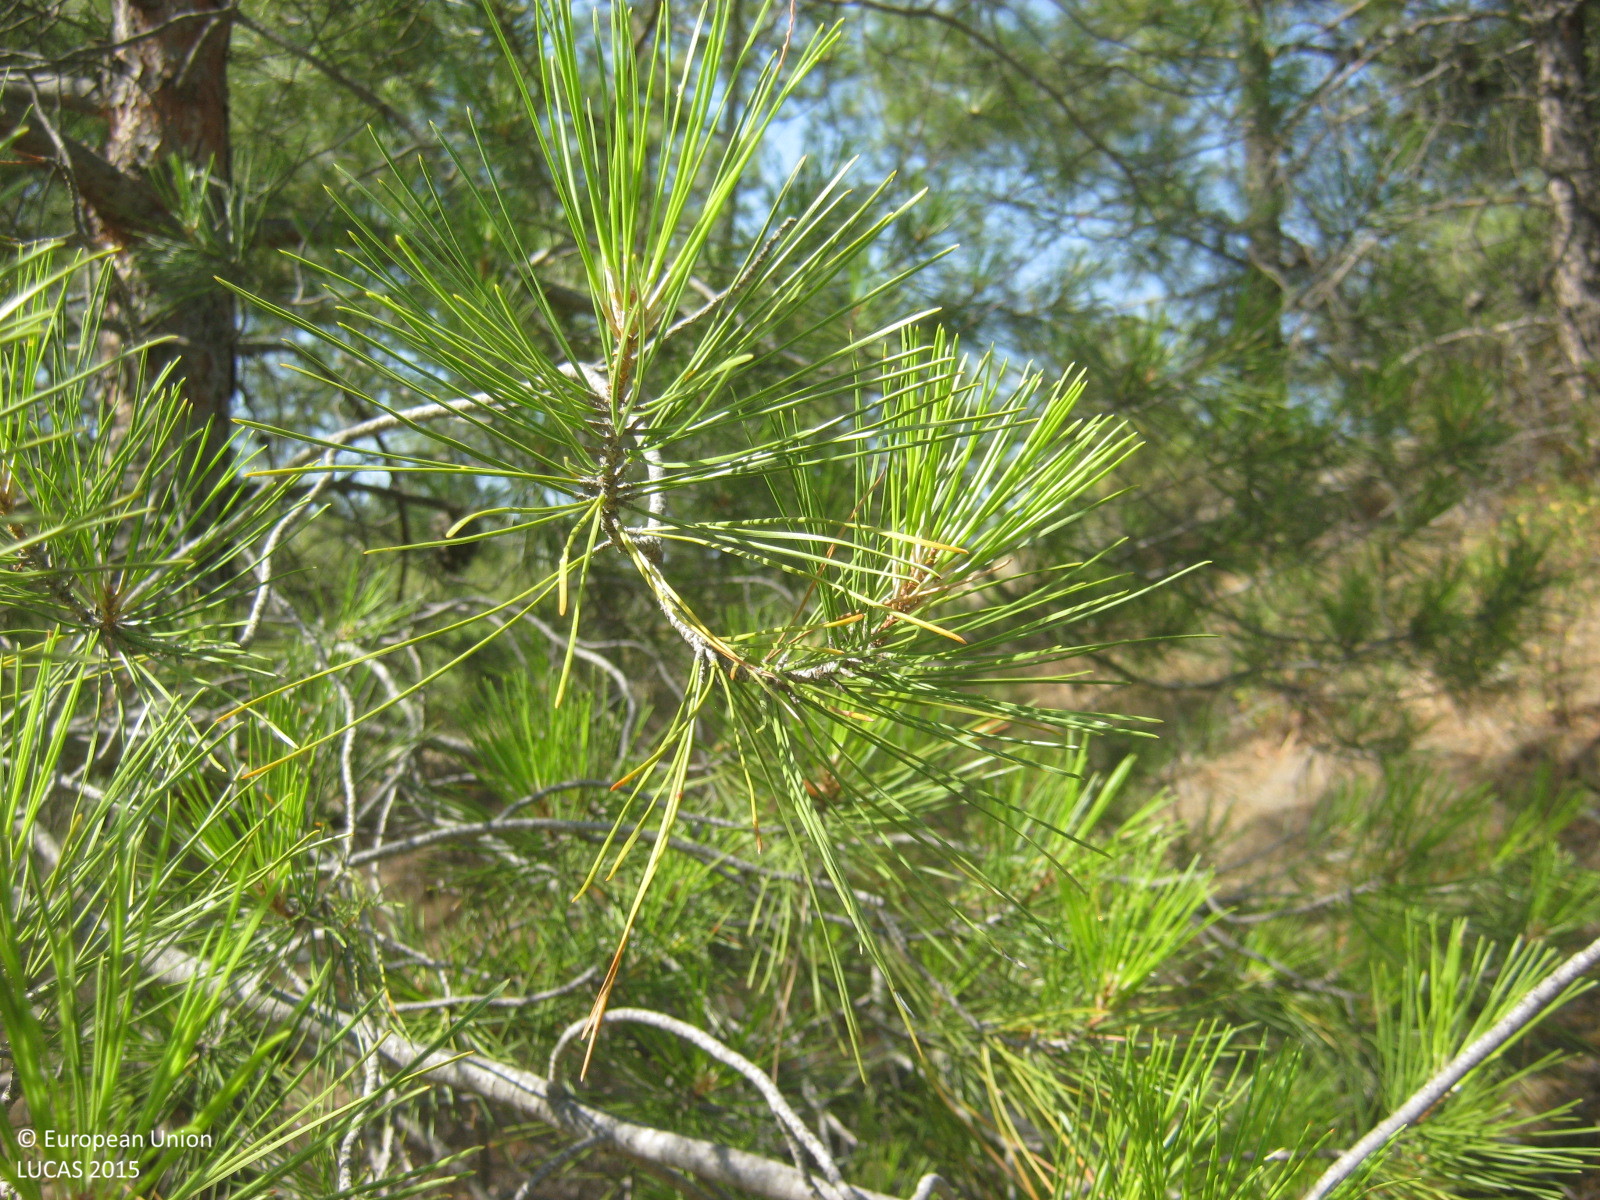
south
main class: Woodland
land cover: Pine dominated coniferous woodland
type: coniferous forest of the mediterranean region
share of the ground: 50 - 75 %
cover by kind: coniferous forest trees 60 %, shrubs 15 %, herbaceous plants 10 %, unconsolidated bare surface 10 %, broadleaved forest trees 5 %
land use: Forestry
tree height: > 5 m
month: June
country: CY
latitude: 35.0410
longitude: 32.9871
